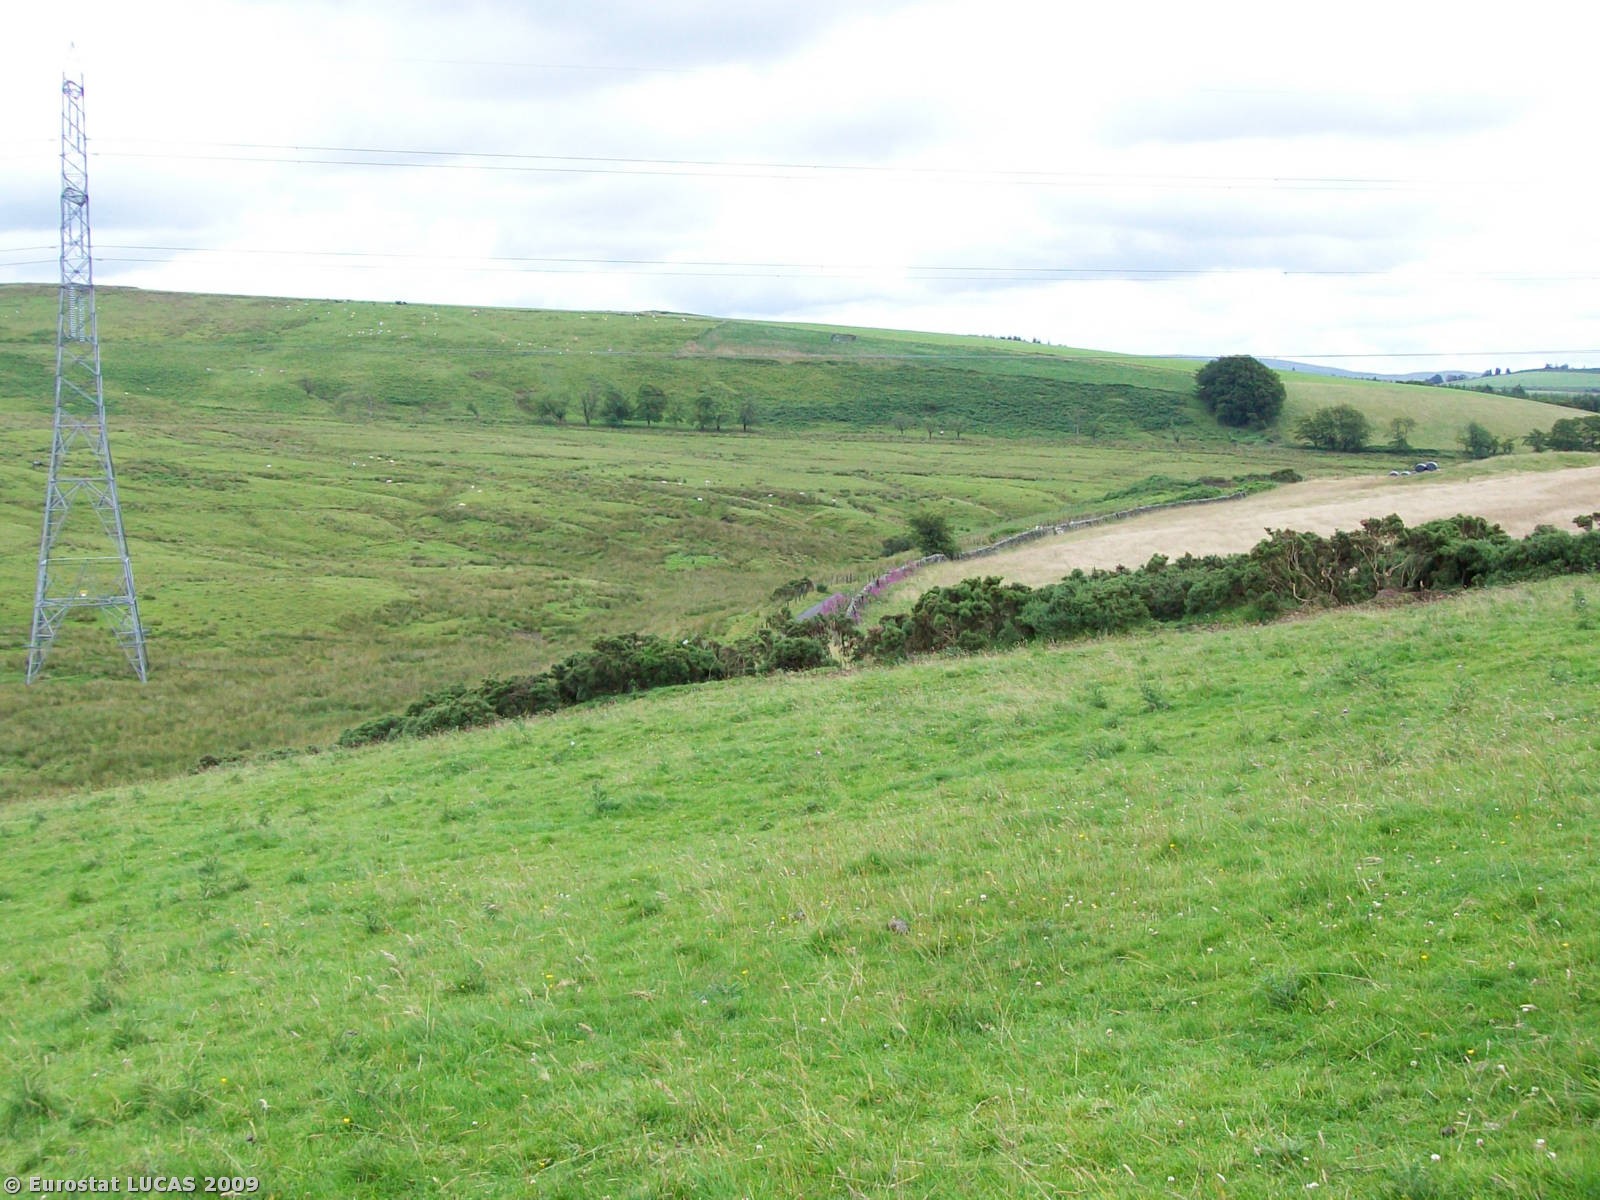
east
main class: Grassland
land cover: Grassland without tree/shrub cover
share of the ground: > 75 %
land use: Agriculture (excluding fallow land and kitchen gardens)
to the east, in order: Grassland without tree/shrub cover; Artificial constructions; Shrubland without tree cover; Fences; Grassland without tree/shrub cover; Fences; Dry stone walls; Single bushes/trees; Grass margins; Paved roads, cycling and walking lanes; Grass margins; Fences; Grassland without tree/shrub cover; Electric lines; Grassland without tree/shrub cover
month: July
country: GB
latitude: 55.1619
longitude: -3.3085
